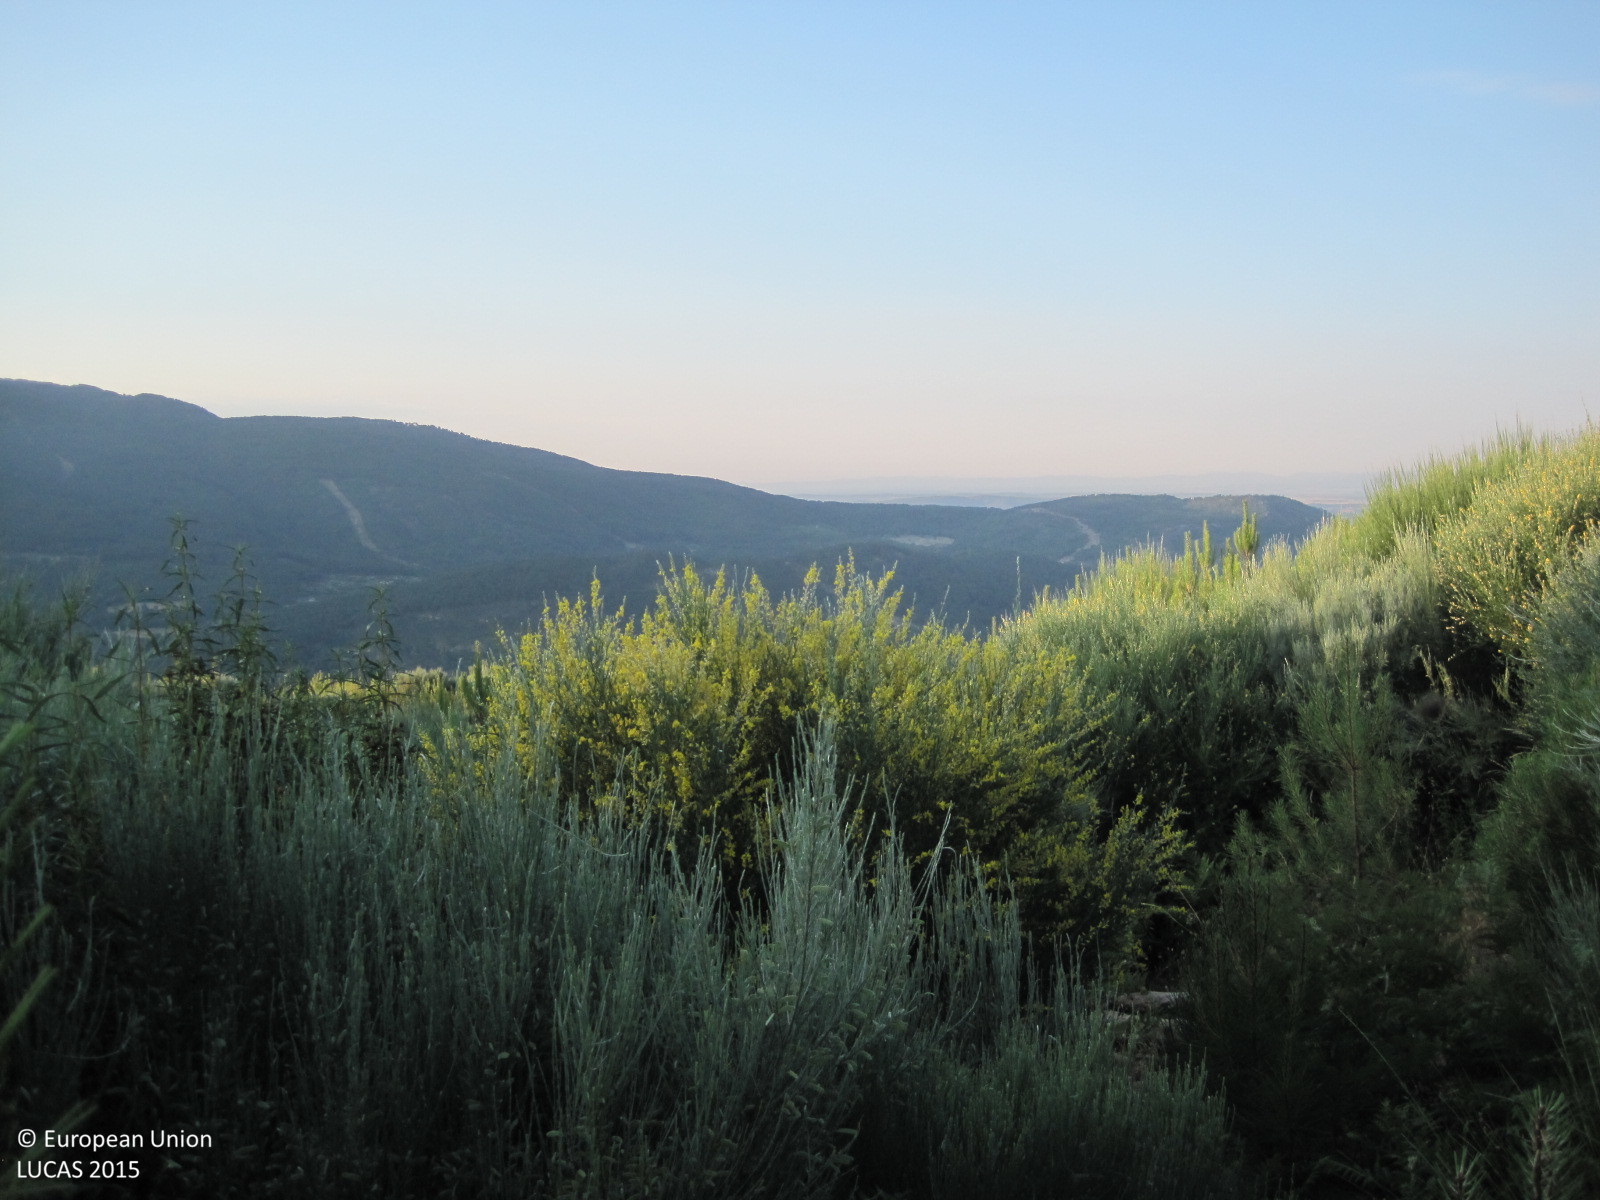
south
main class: Woodland
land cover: Pine dominated coniferous woodland
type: coniferous forest of the mediterranean region
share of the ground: > 75 %
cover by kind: coniferous forest trees 90 %, shrubs 10 %
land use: Forestry
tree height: < 5 m
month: June
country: ES
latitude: 40.2565
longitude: -5.0463
